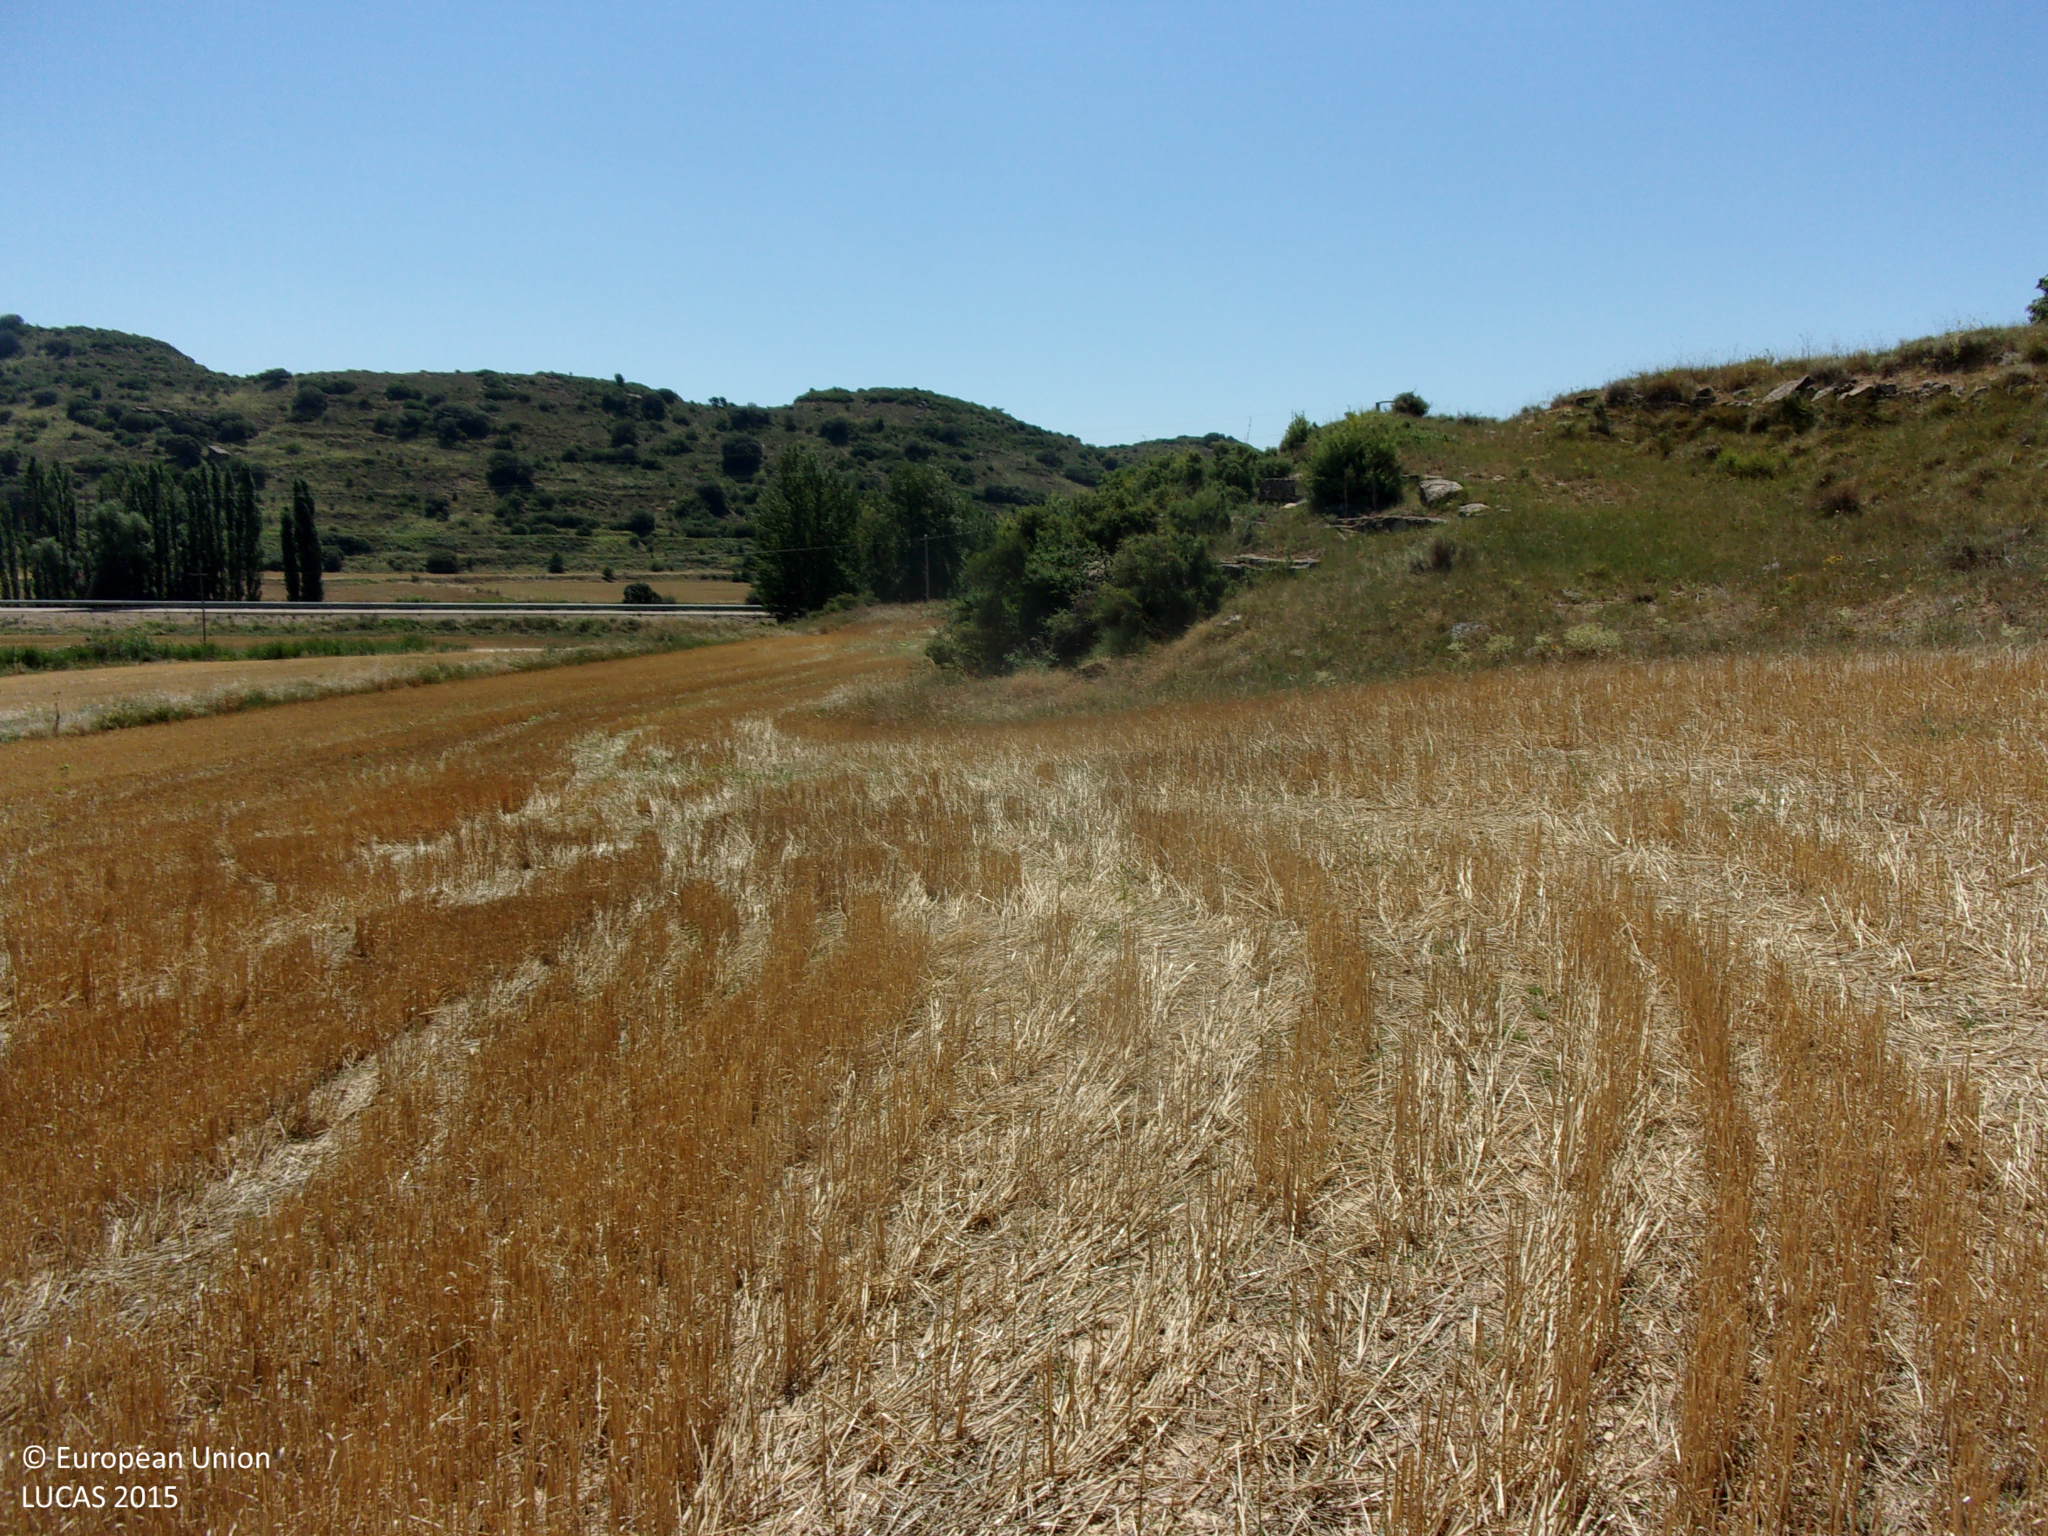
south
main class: Cropland
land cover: Common wheat
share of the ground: < 10 %
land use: Agriculture (excluding fallow land and kitchen gardens)
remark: Harvested field
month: August
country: ES
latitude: 42.3448
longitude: -1.1614
